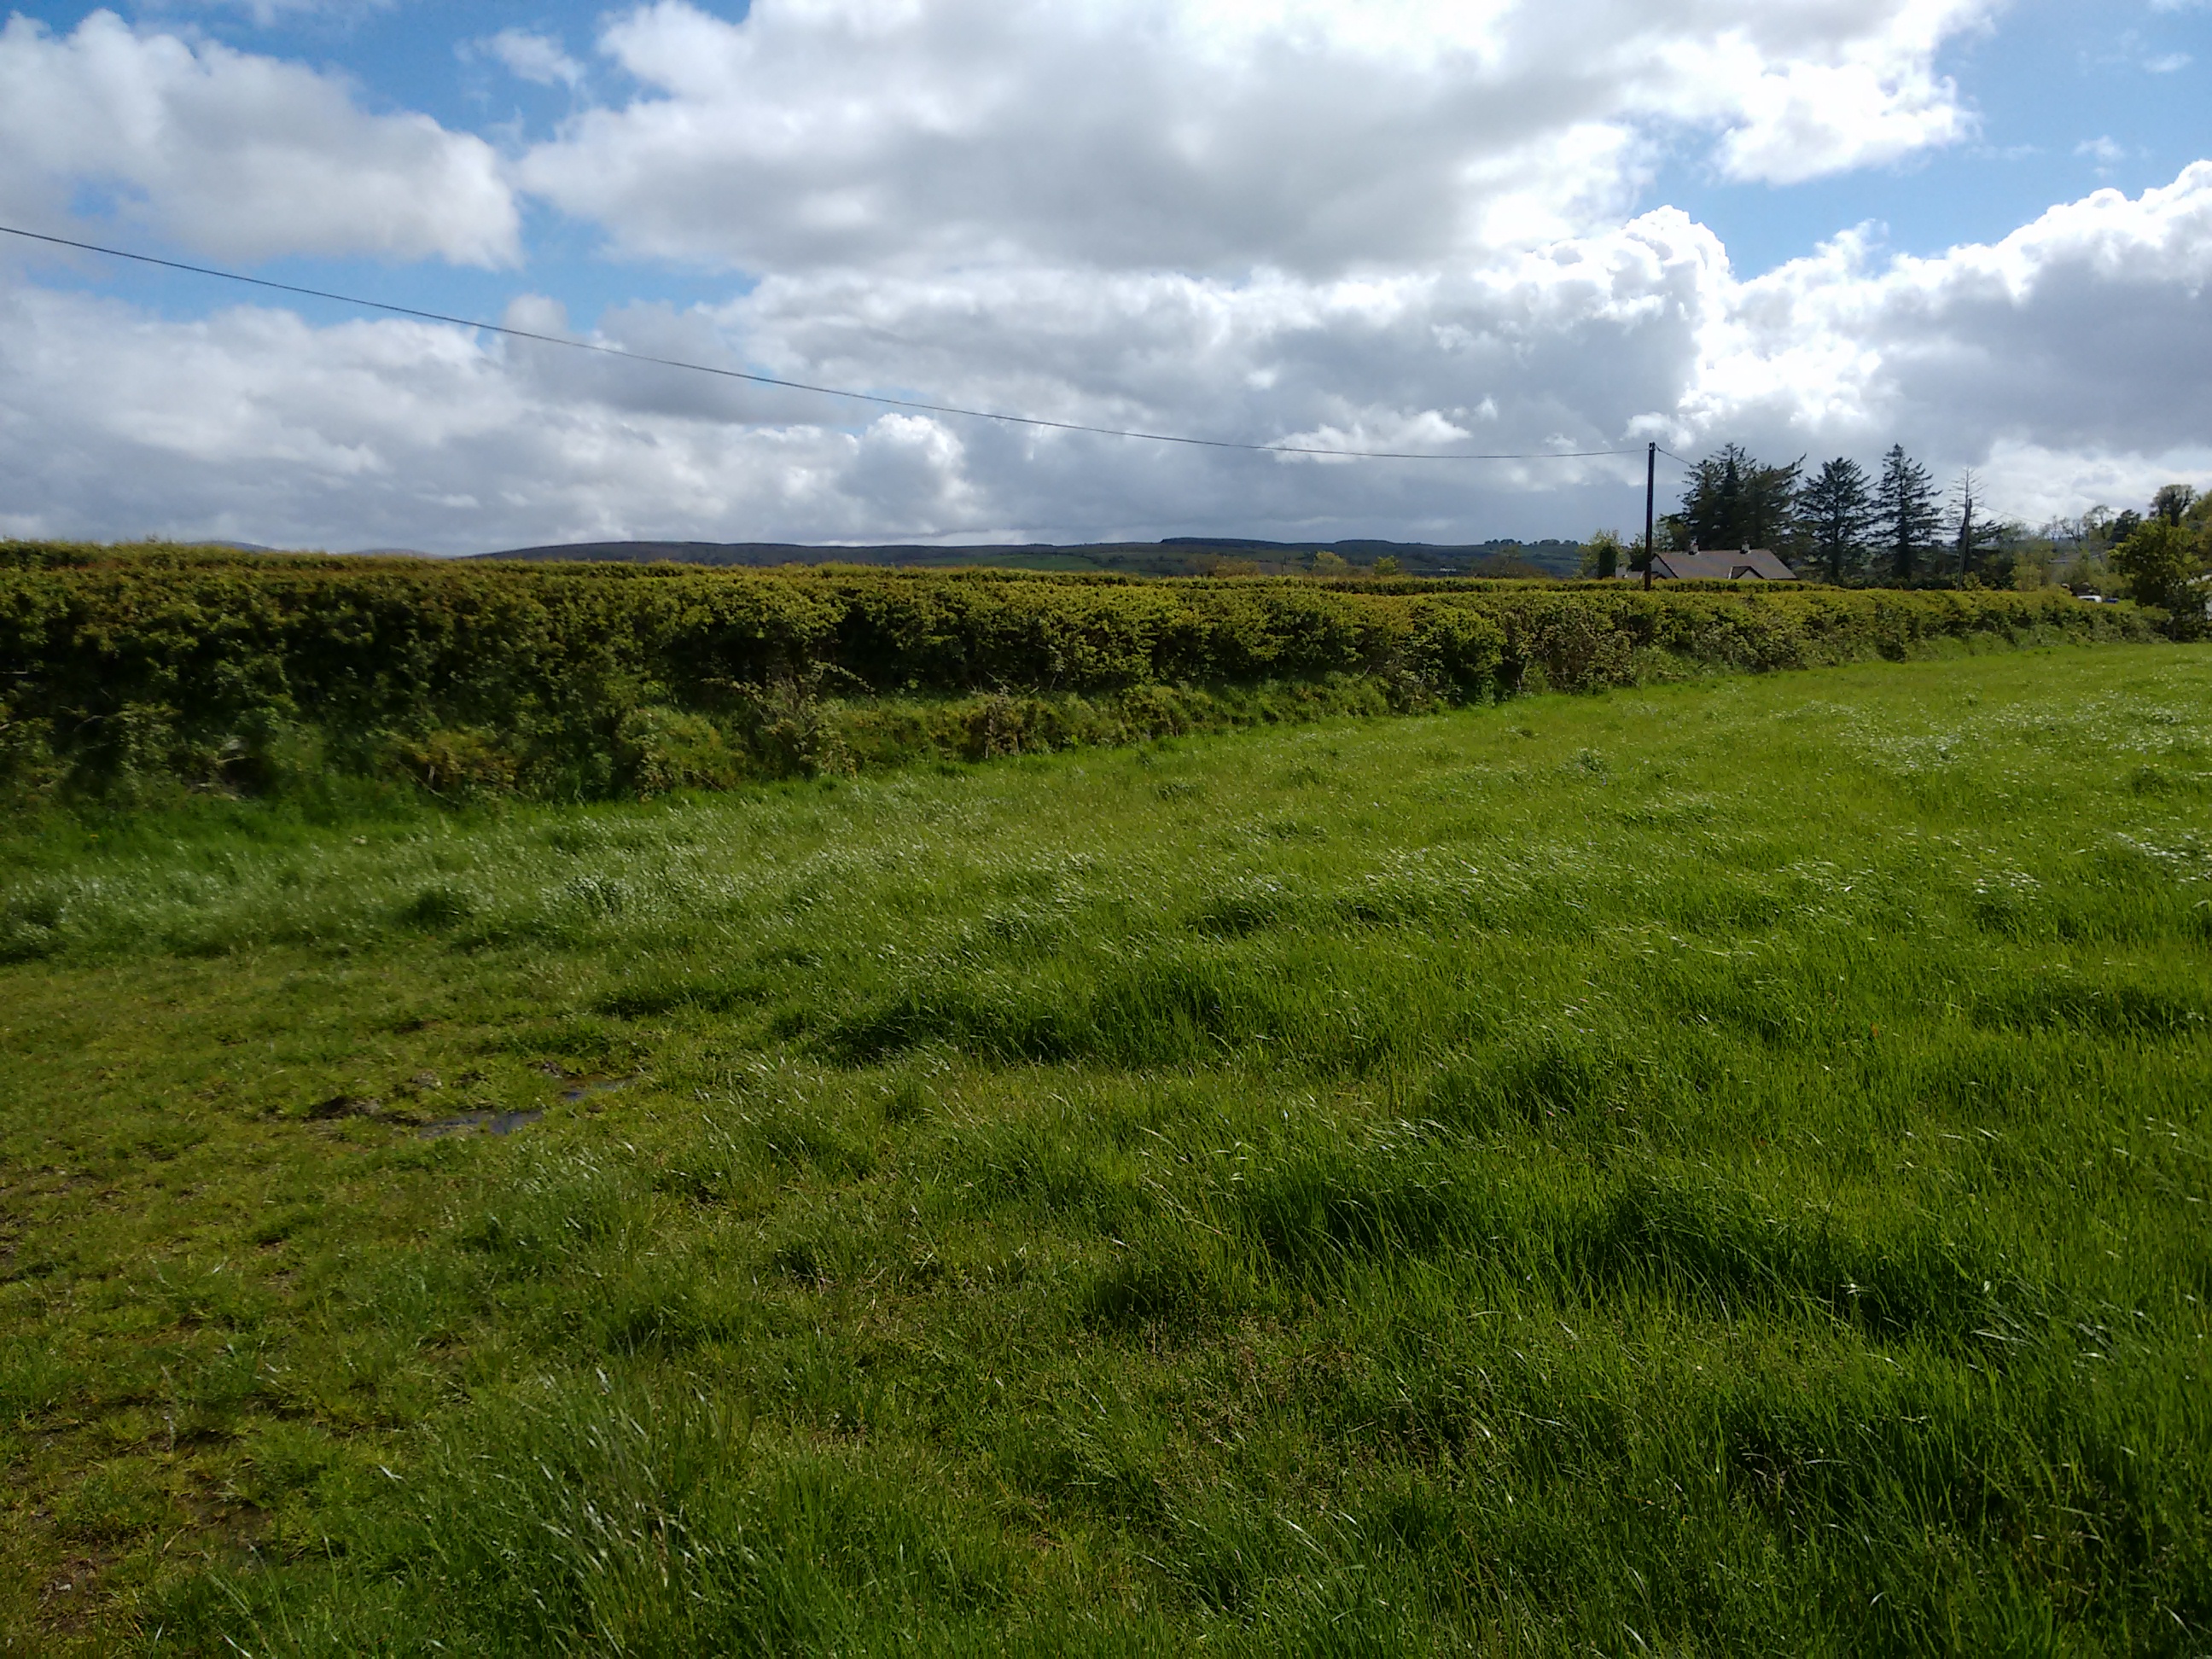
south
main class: Grassland
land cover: Grassland without tree/shrub cover
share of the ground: > 75 %
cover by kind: herbaceous plants 100 %
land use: Agriculture (excluding fallow land and kitchen gardens)
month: May
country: GB
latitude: 54.9166
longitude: -7.2281
